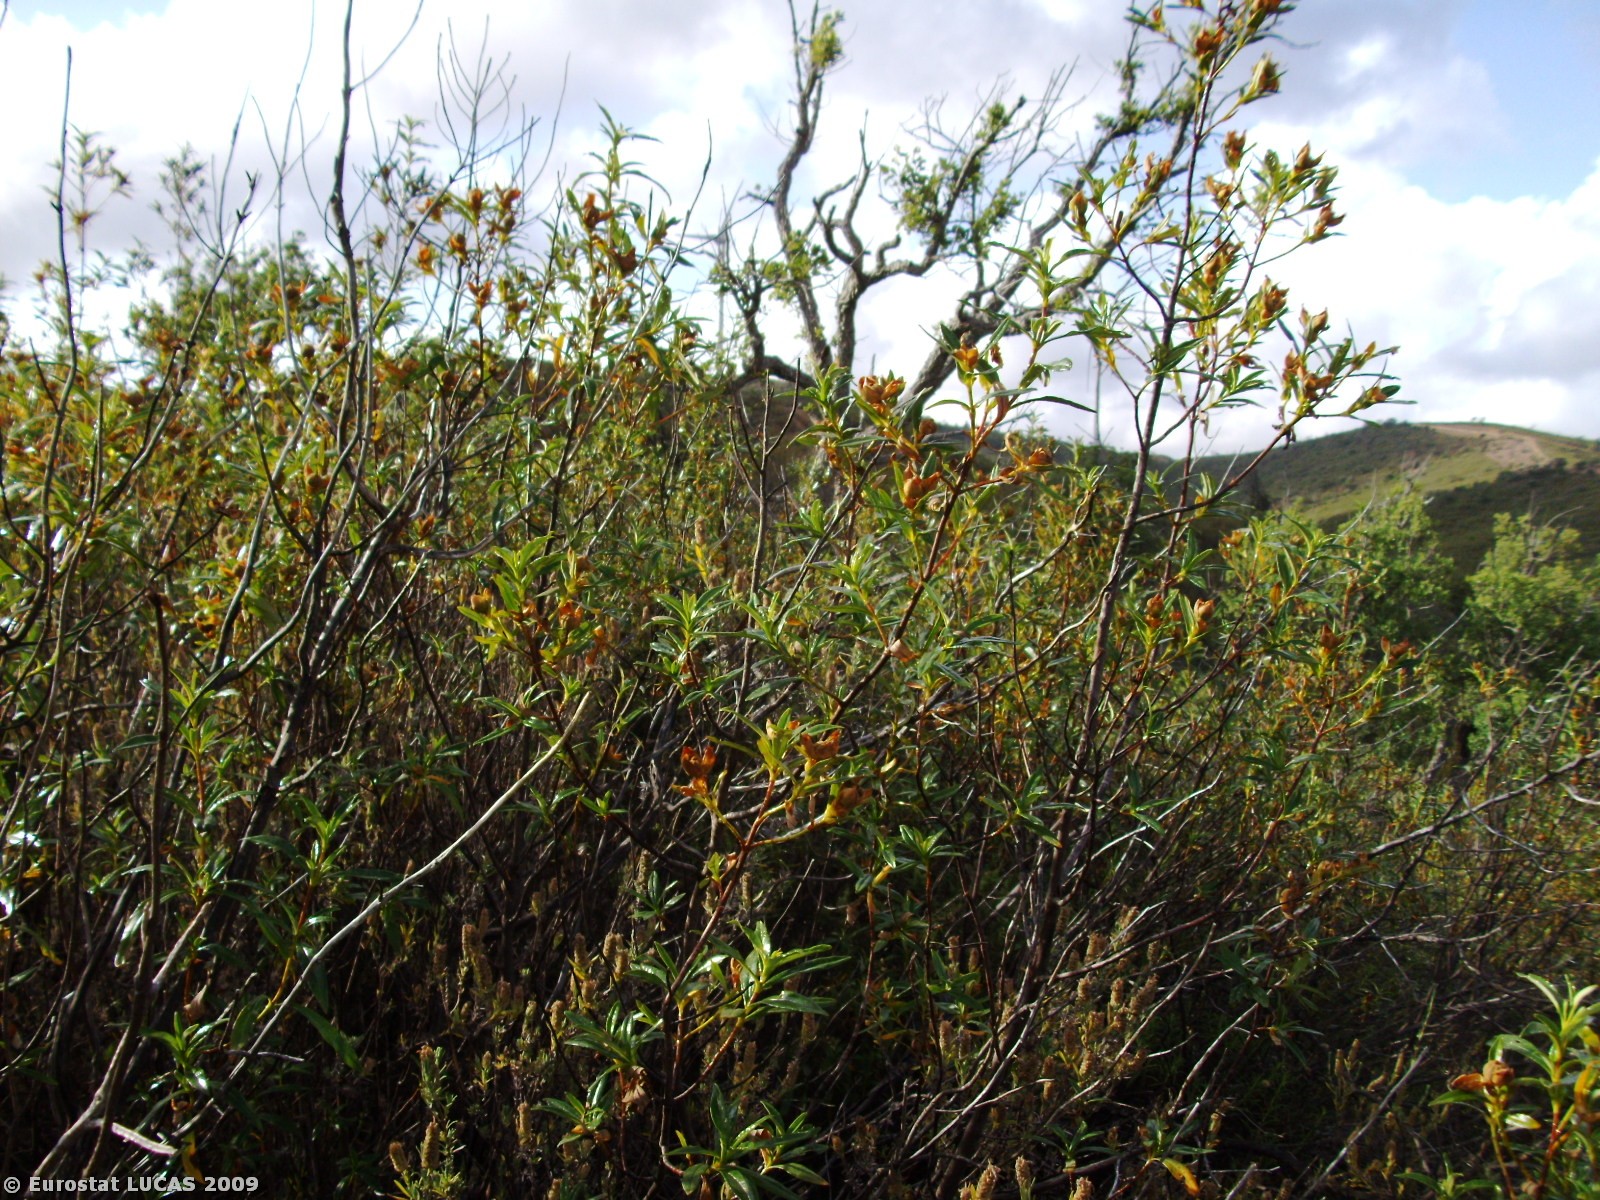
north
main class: Shrubland
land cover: Shrubland without tree cover
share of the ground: > 75 %
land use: Unused
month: June
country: PT
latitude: 37.2182
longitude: -8.7509
